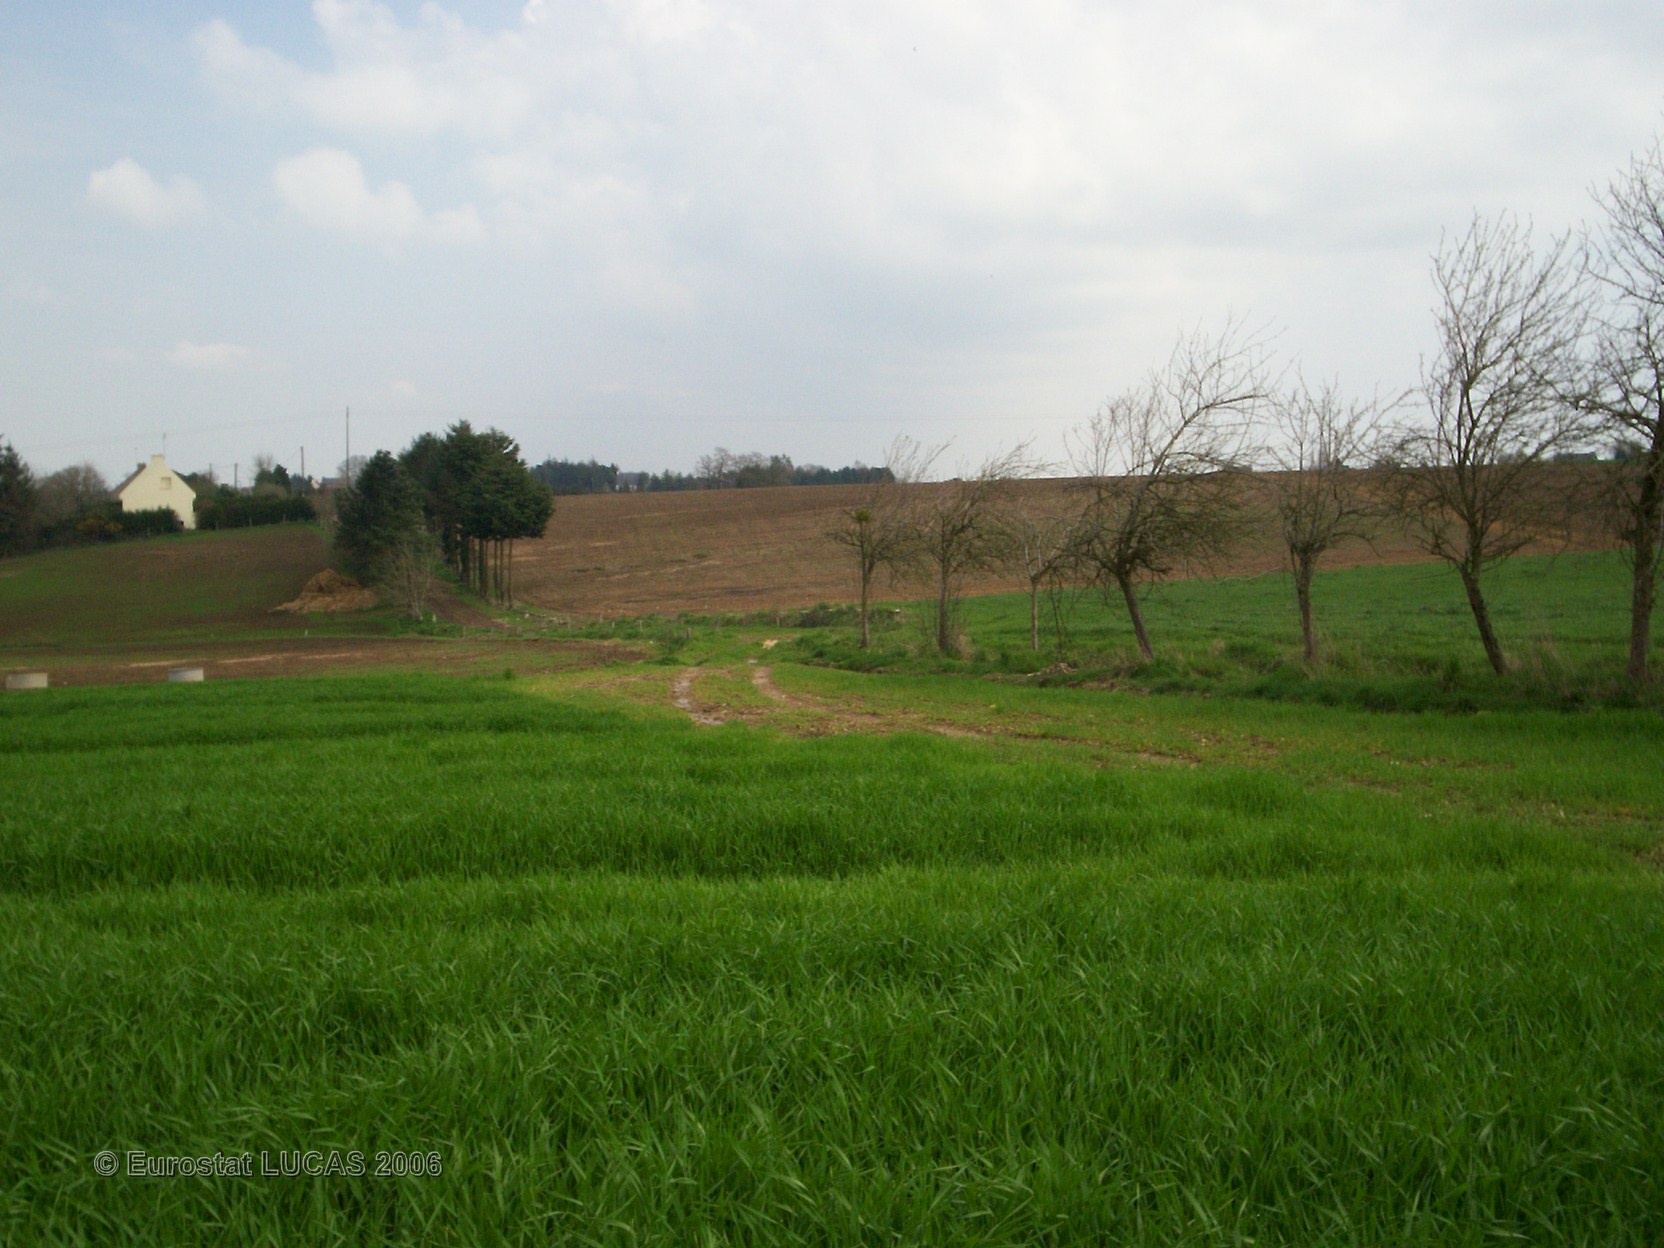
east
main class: Cropland
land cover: Barley
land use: Agriculture (excluding fallow land and kitchen gardens)
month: April
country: FR
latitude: 48.0600
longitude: -2.7712
